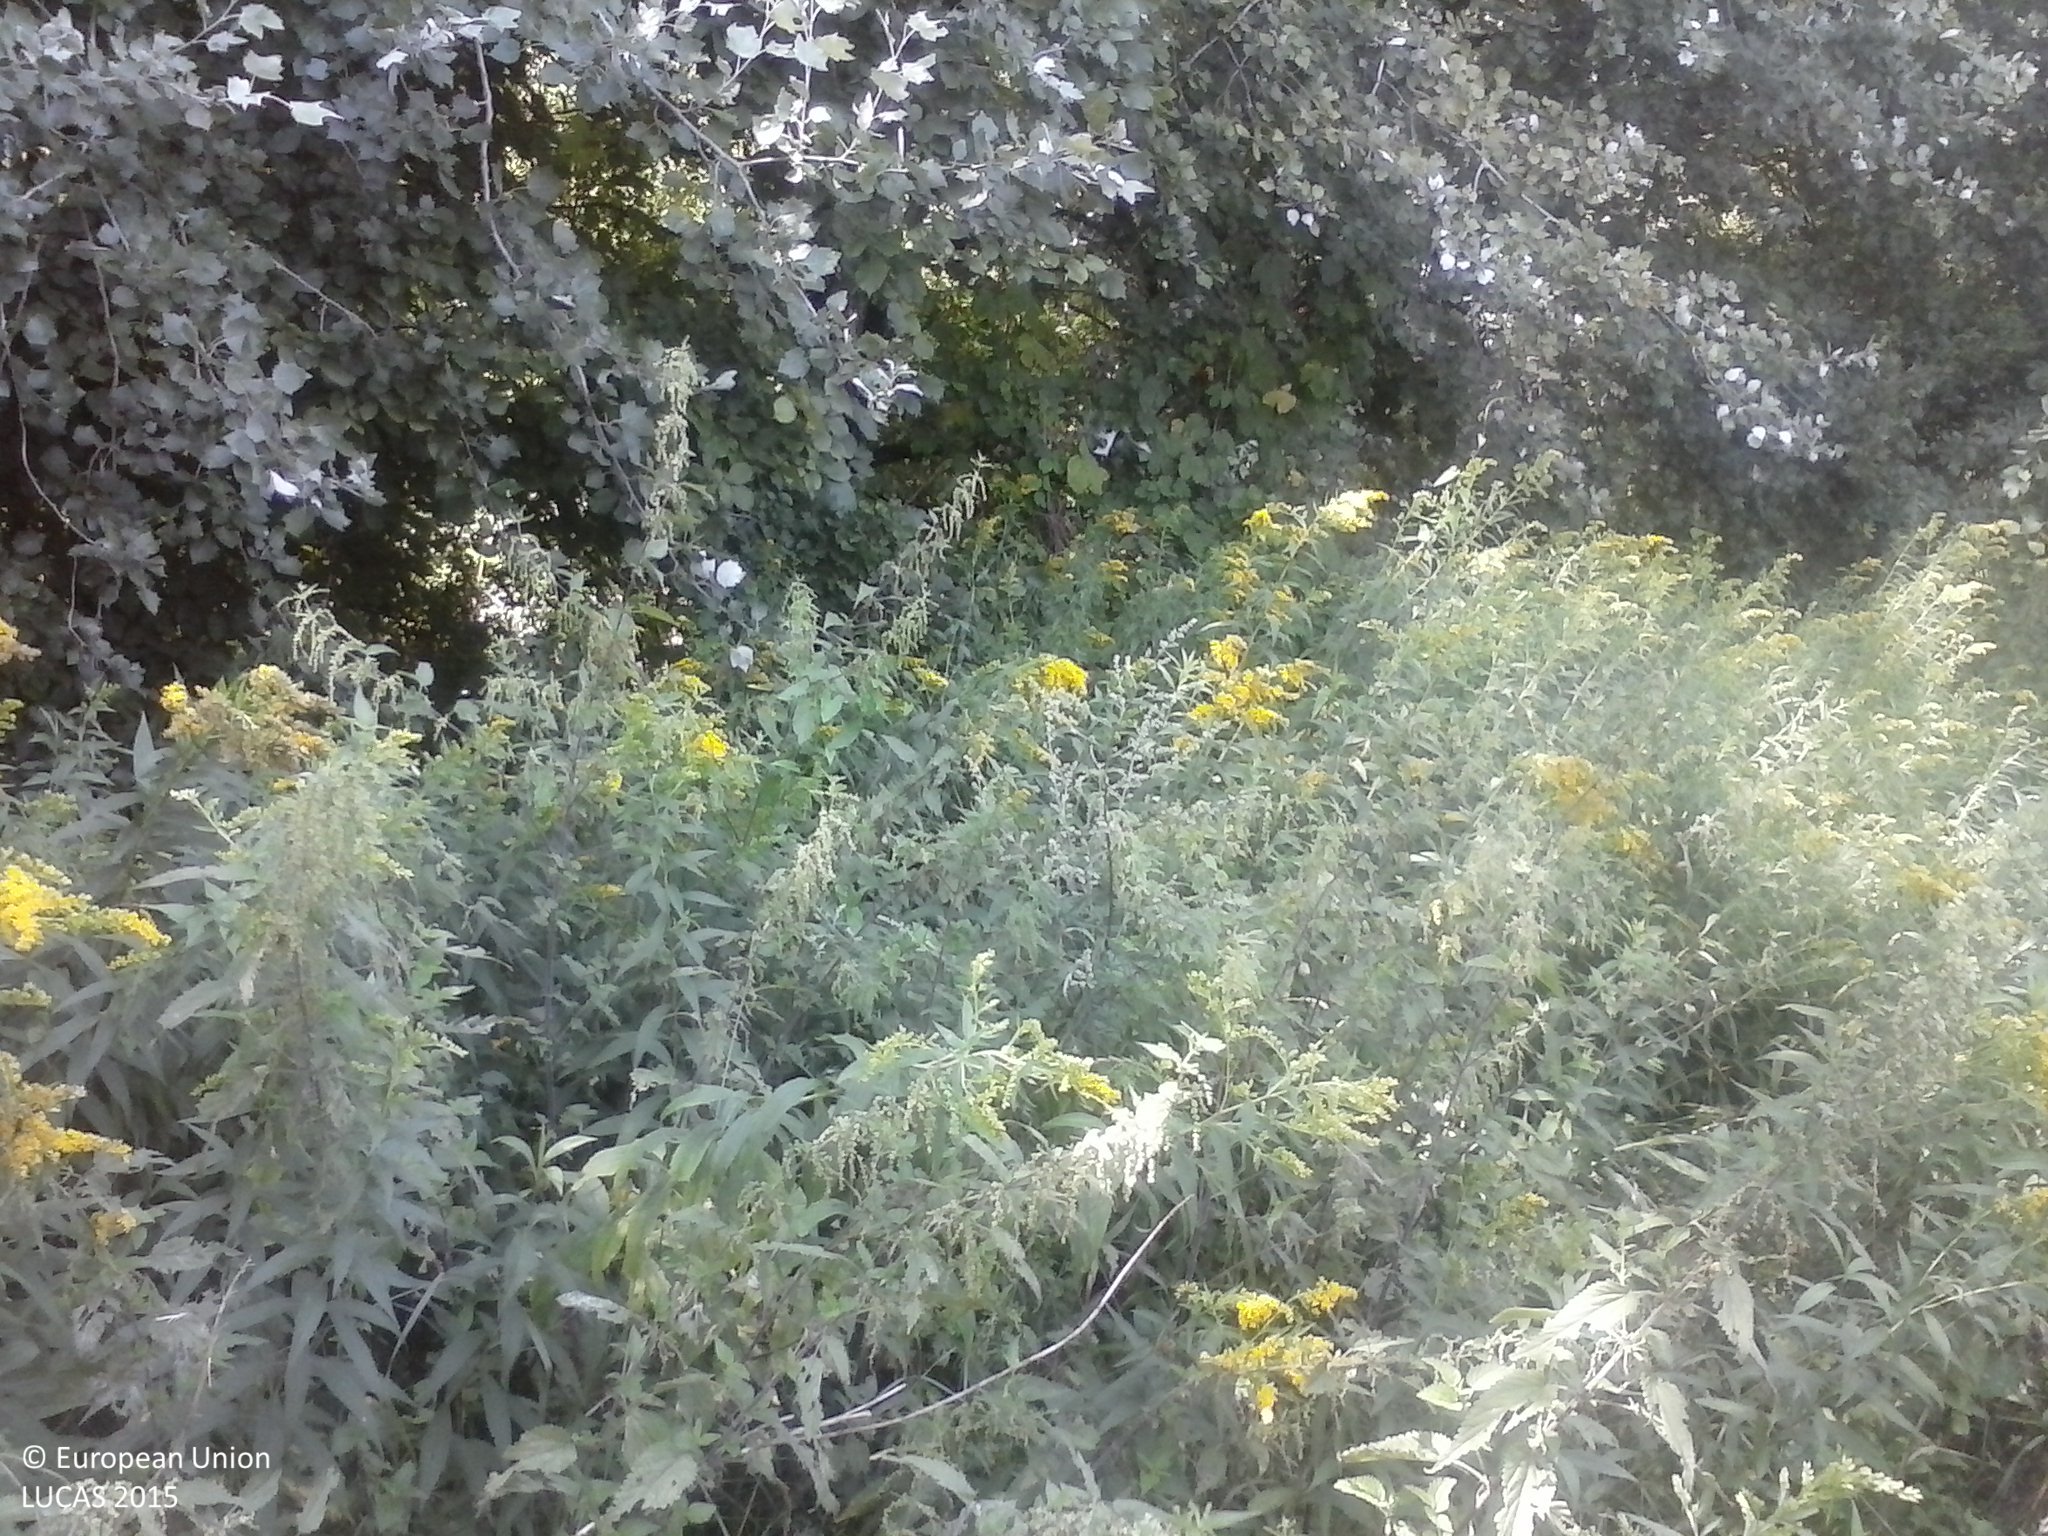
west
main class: Cropland
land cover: Maize
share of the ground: > 75 %
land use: Agriculture (excluding fallow land and kitchen gardens)
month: August
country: HU
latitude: 45.8993
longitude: 17.8540
